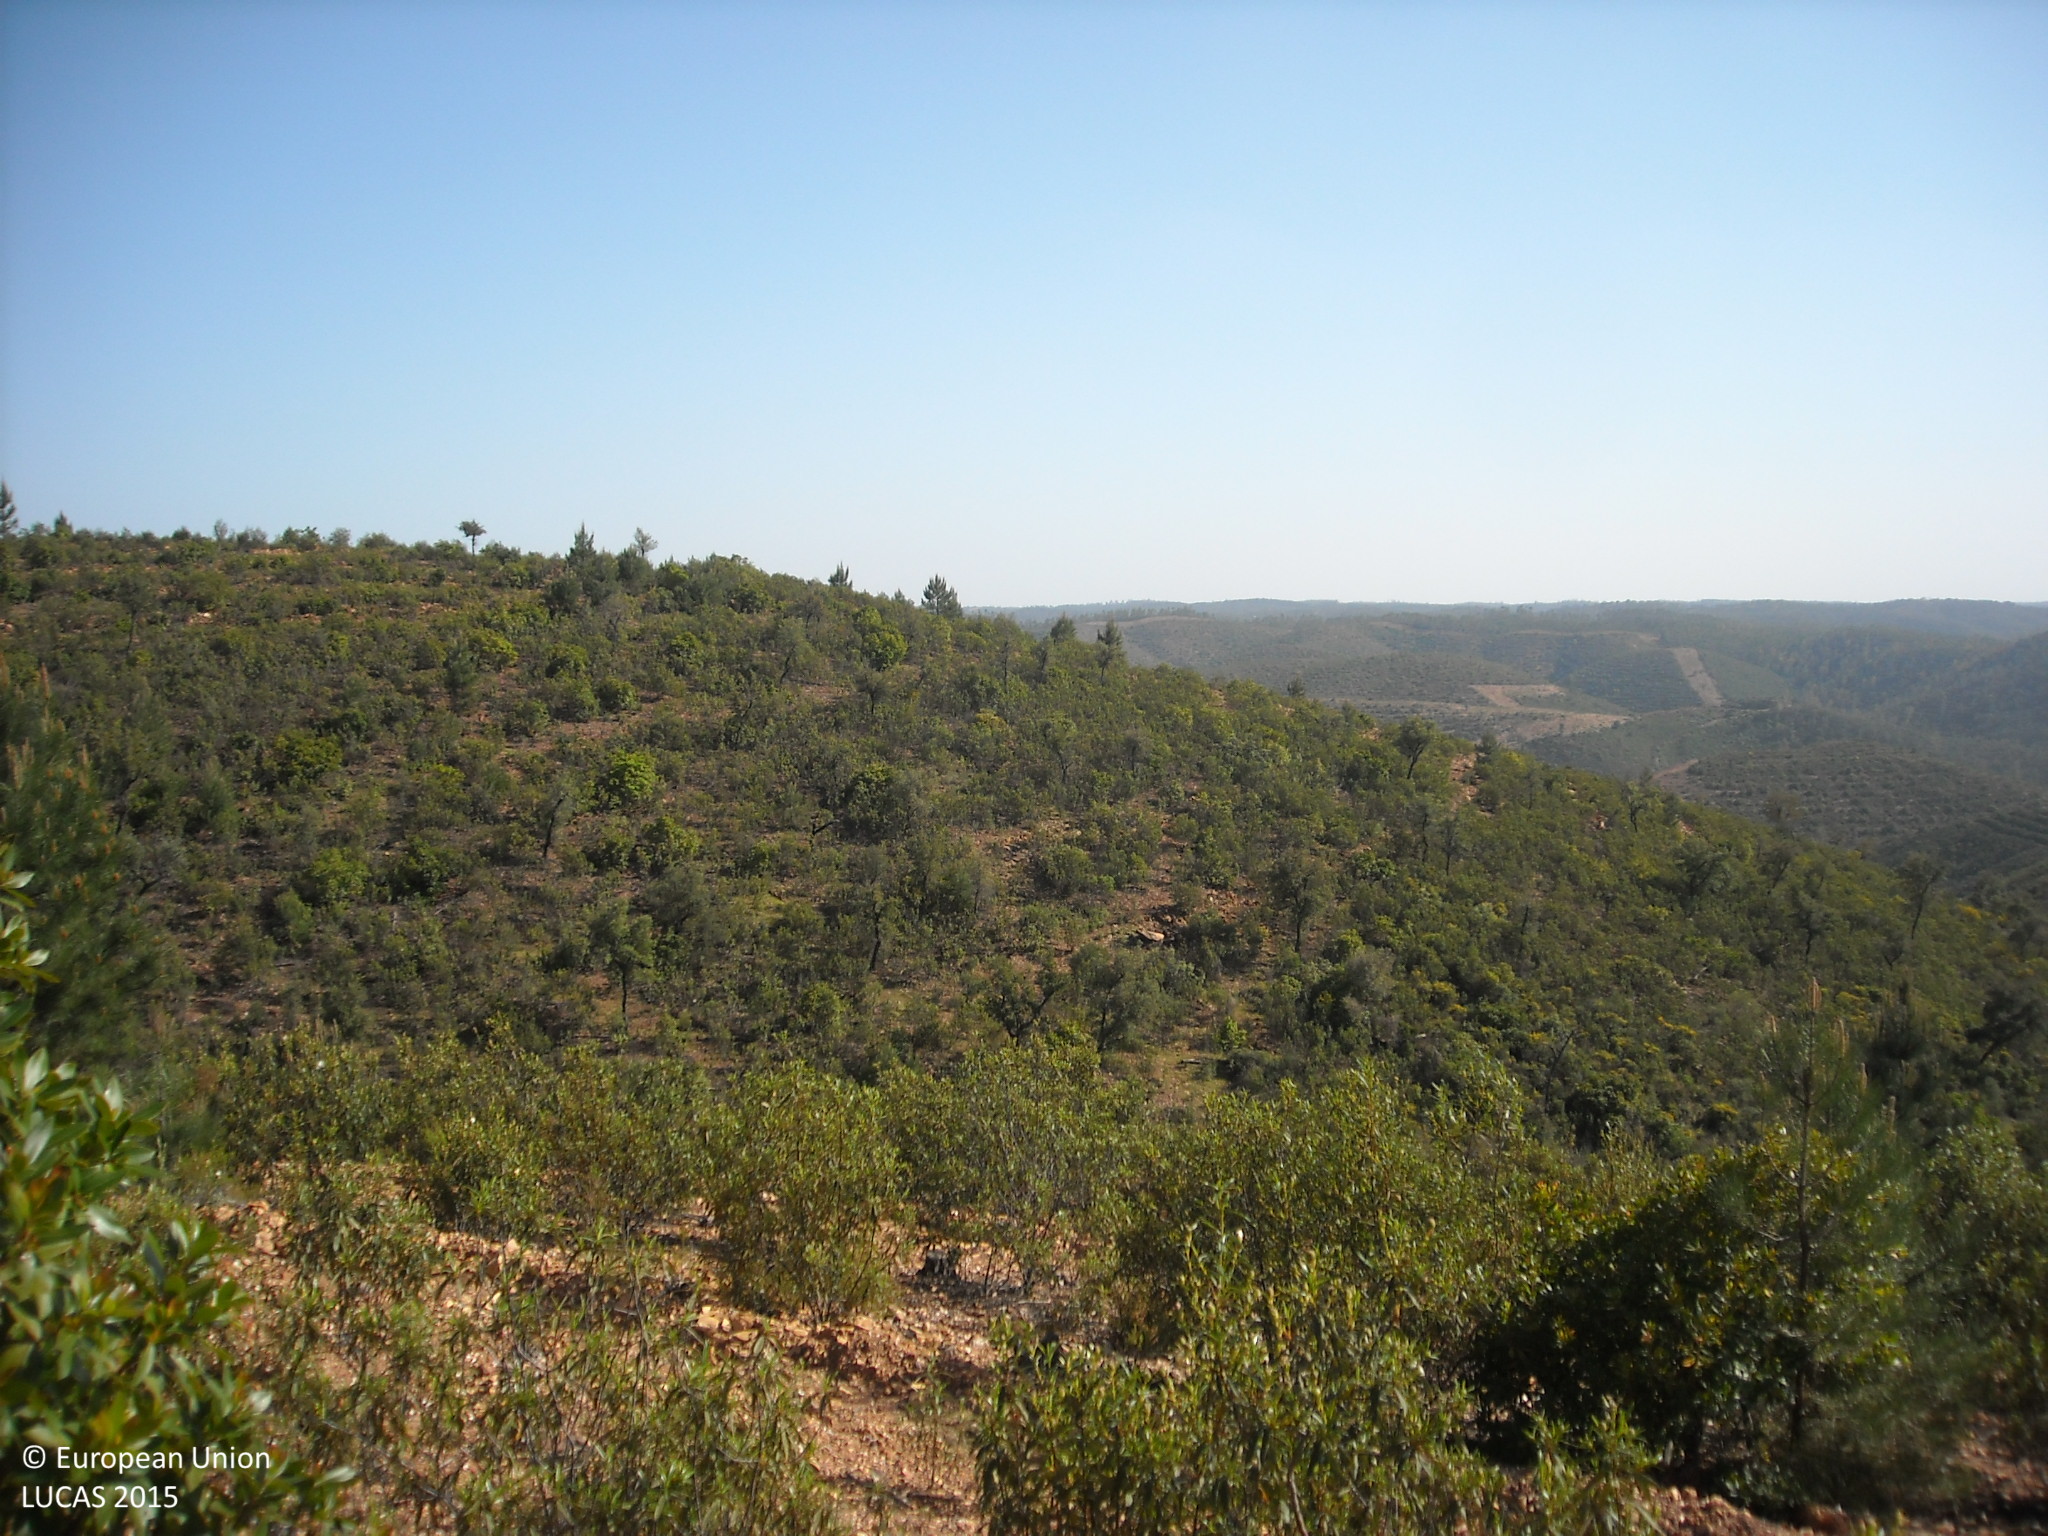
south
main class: Shrubland
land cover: Shrubland without tree cover
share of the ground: 50 - 75 %
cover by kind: shrubs 50 %, herbaceous plants 50 %
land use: Semi-natural and natural areas not in use
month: April
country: ES
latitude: 37.6320
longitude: -6.4557
